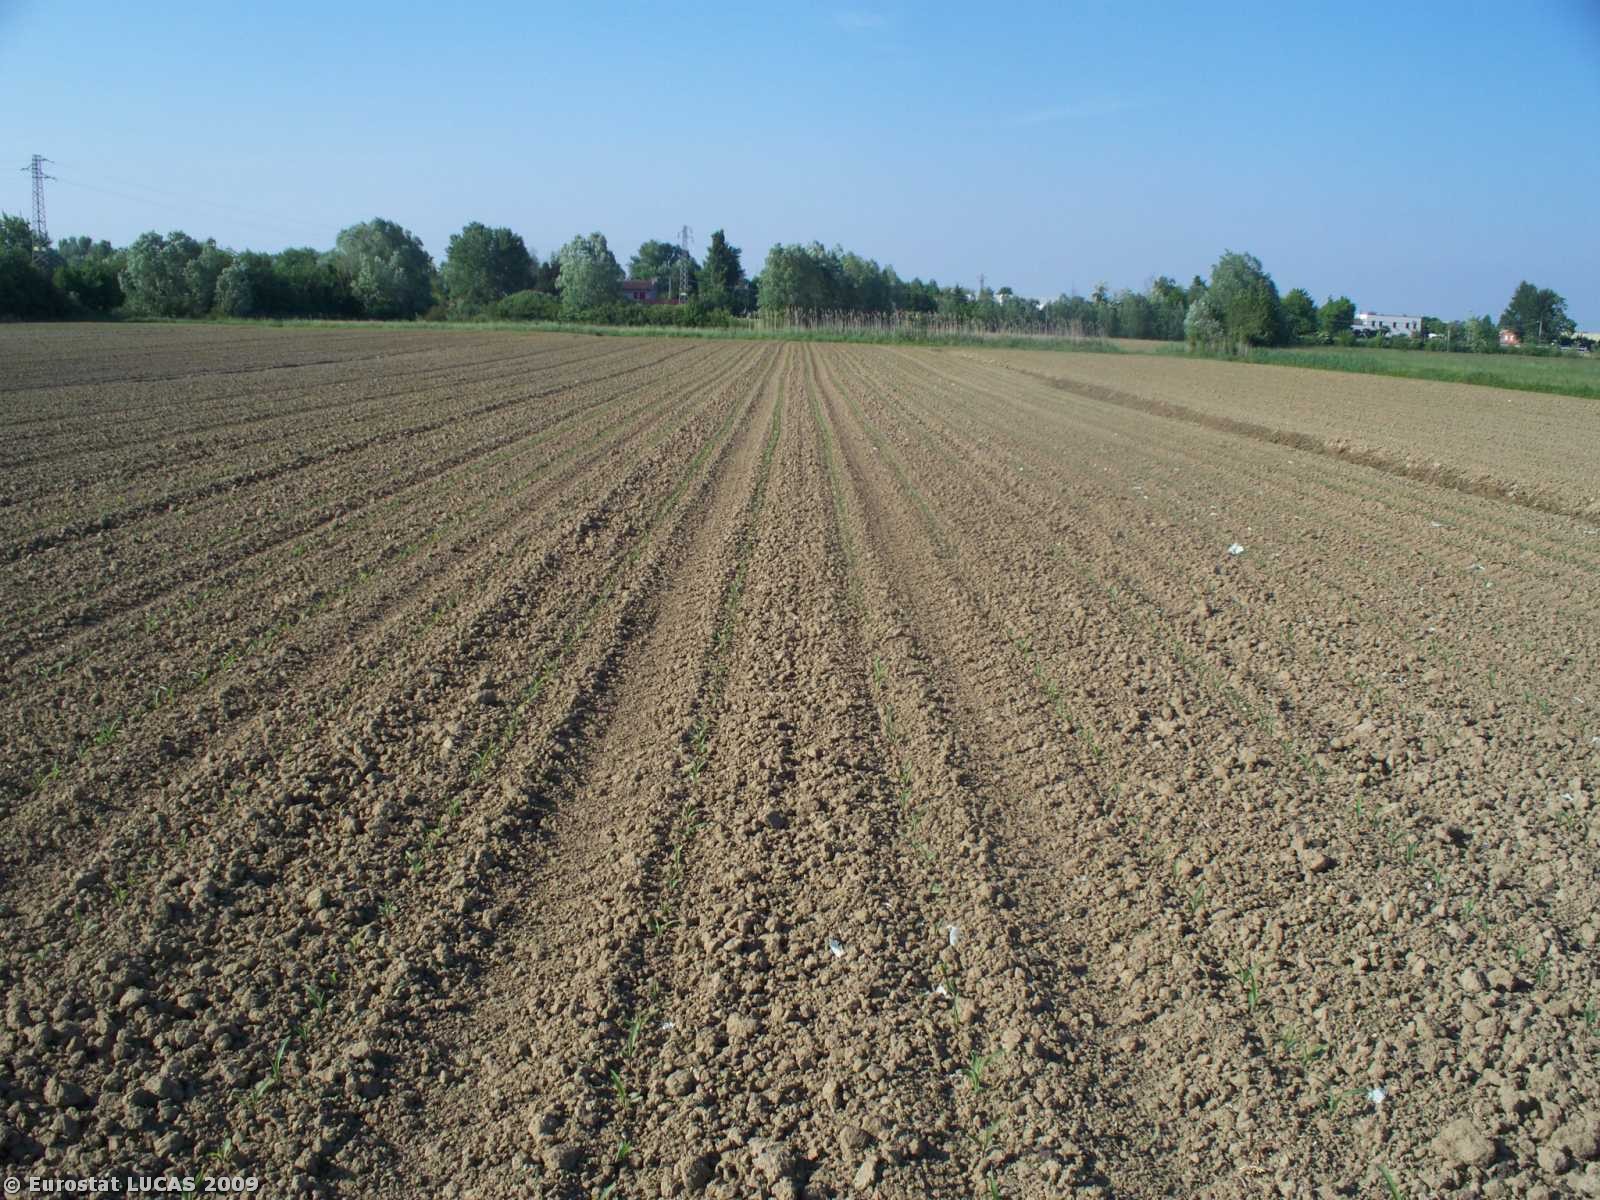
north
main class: Cropland
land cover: Maize
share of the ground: < 10 %
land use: Agriculture (excluding fallow land and kitchen gardens)
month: May
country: IT
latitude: 45.5199
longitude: 12.0835
